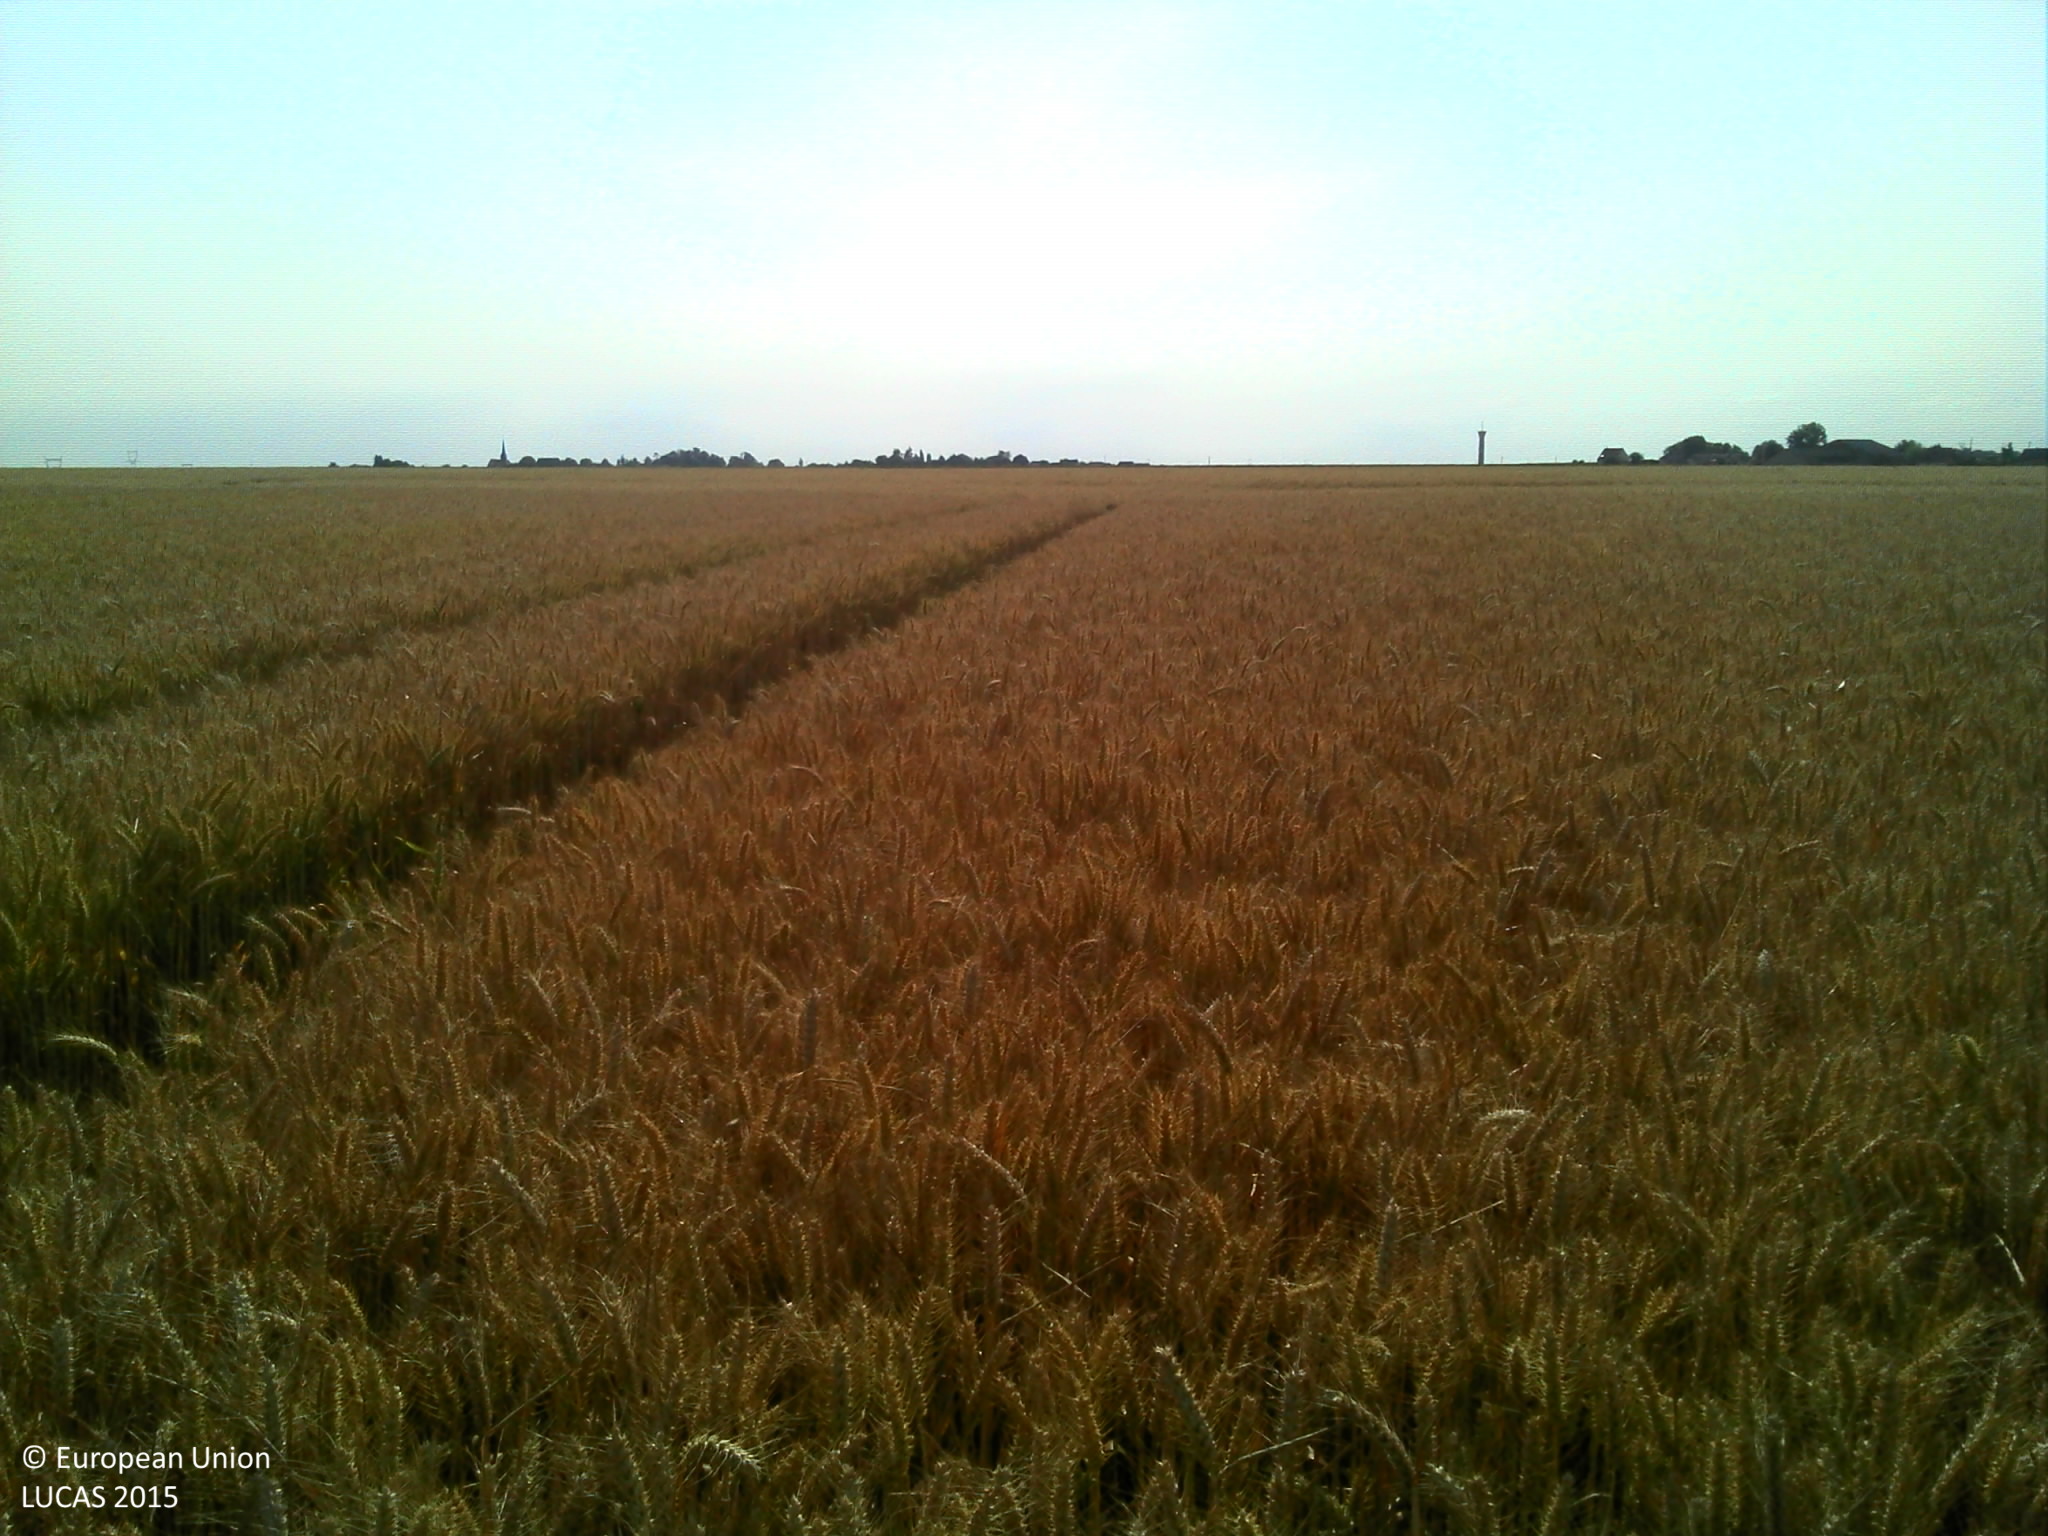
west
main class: Cropland
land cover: Common wheat
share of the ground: > 75 %
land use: Agriculture (excluding fallow land and kitchen gardens)
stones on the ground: < 10 %
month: July
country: FR
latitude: 48.8719
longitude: 1.2687
